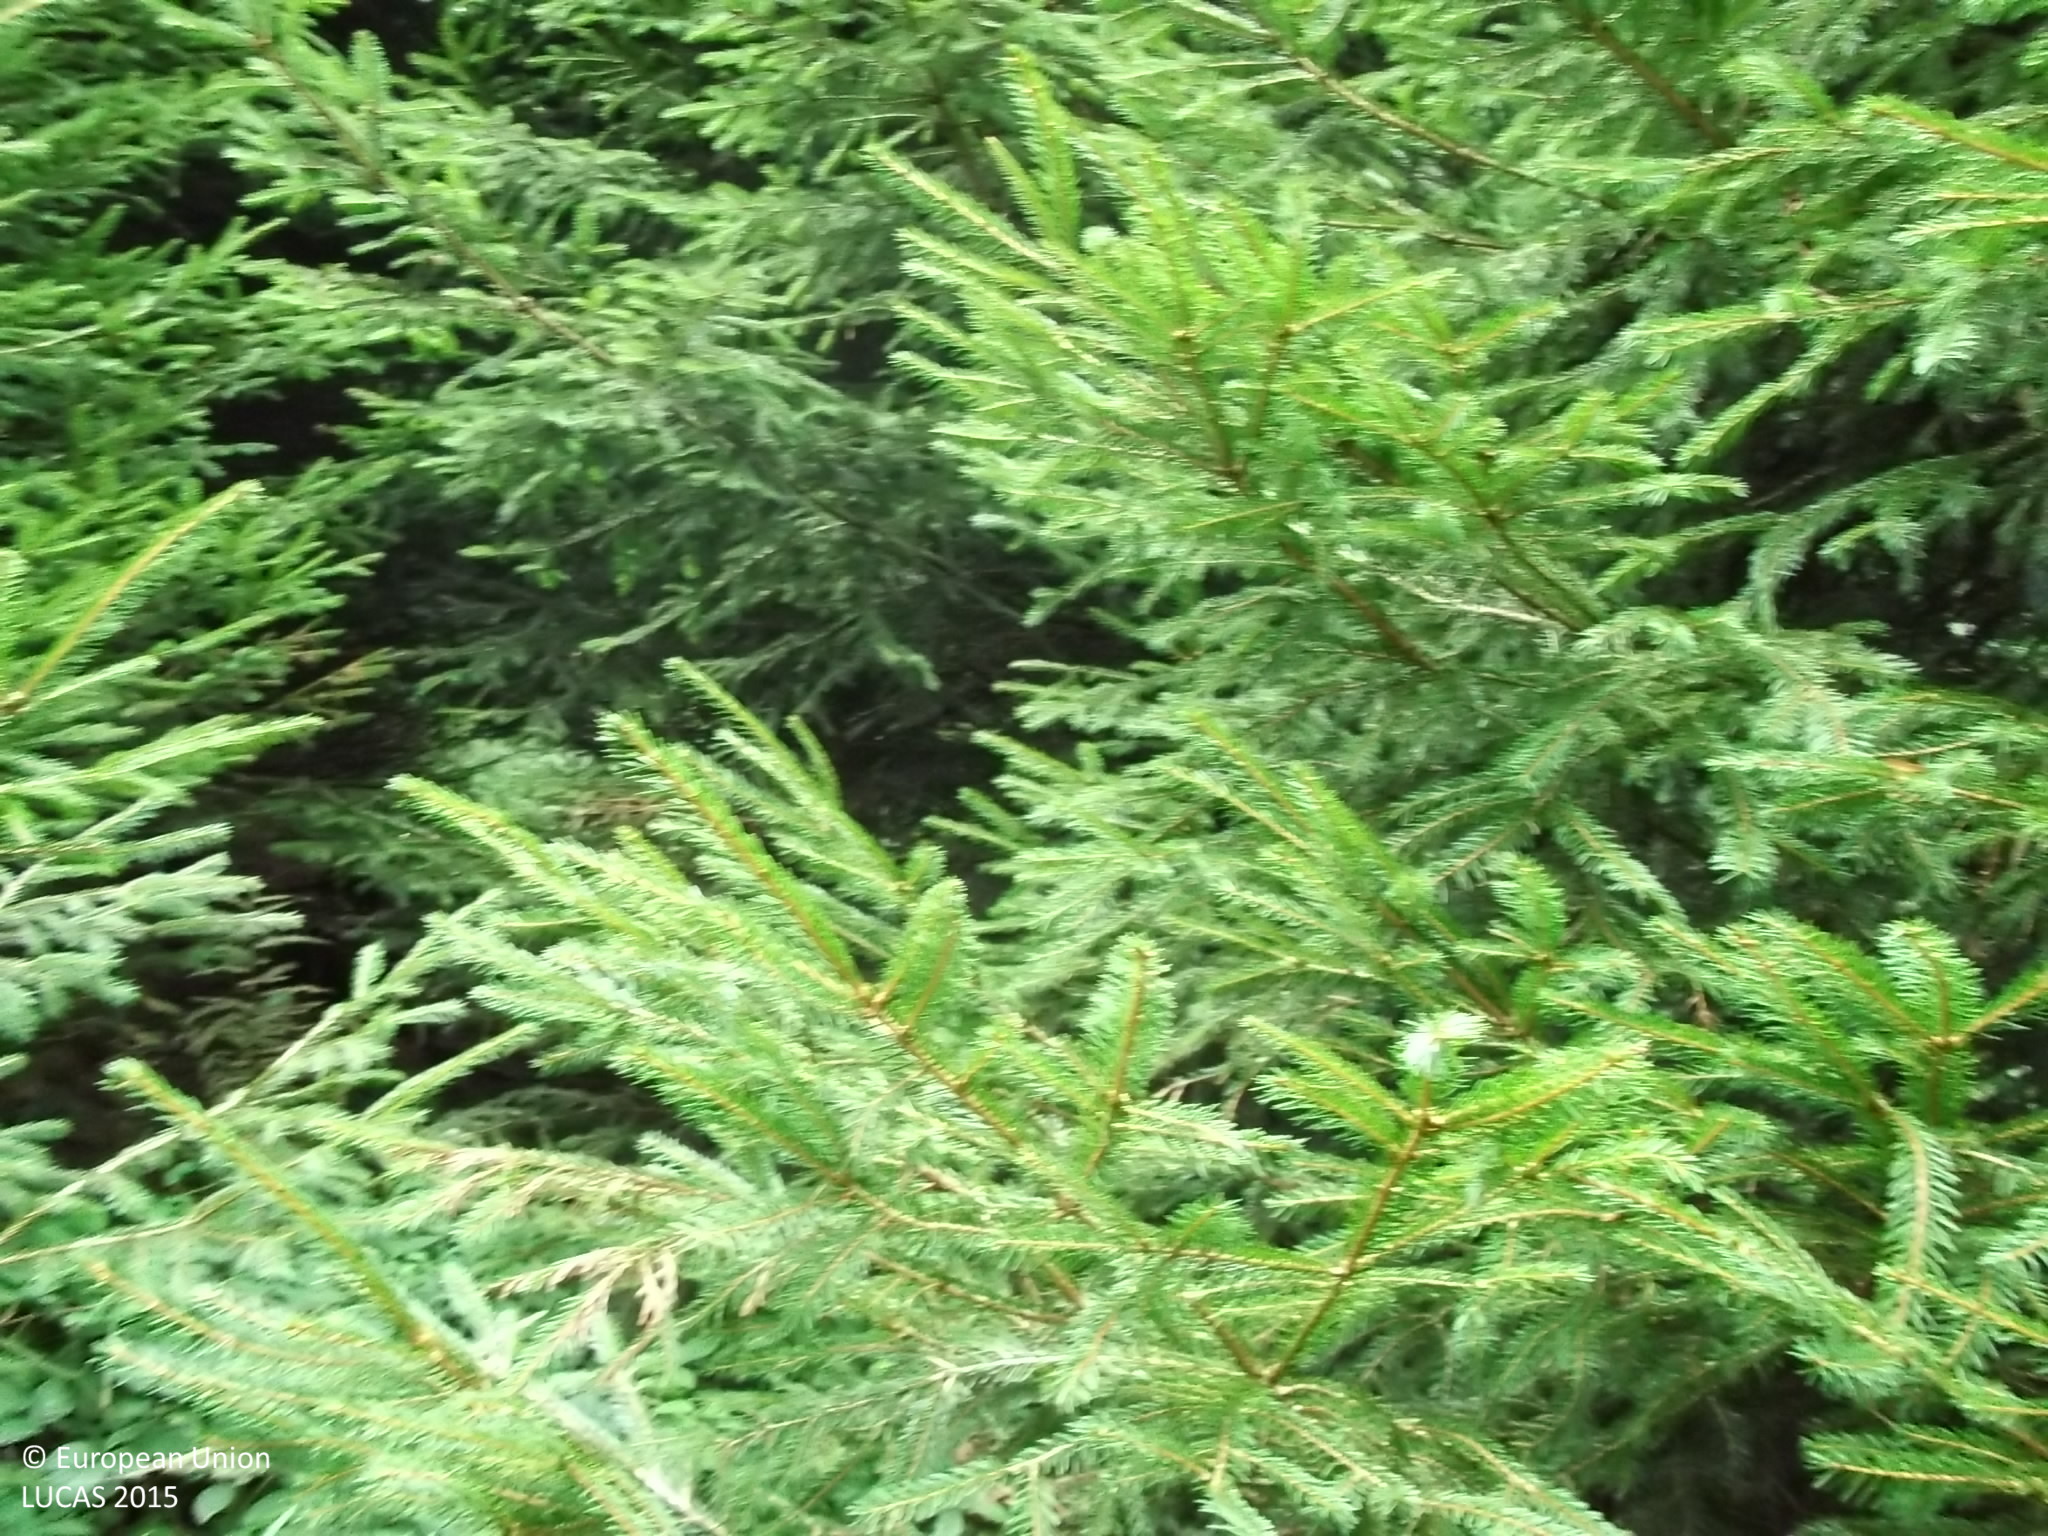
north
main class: Woodland
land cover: Spruce dominated coniferous woodland
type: alpine coniferous forest
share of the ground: > 75 %
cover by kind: coniferous forest trees 85 %, shrubs 10 %, herbaceous plants 5 %
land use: Forestry
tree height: < 5 m
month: August
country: AT
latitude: 47.9571
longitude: 13.3334
